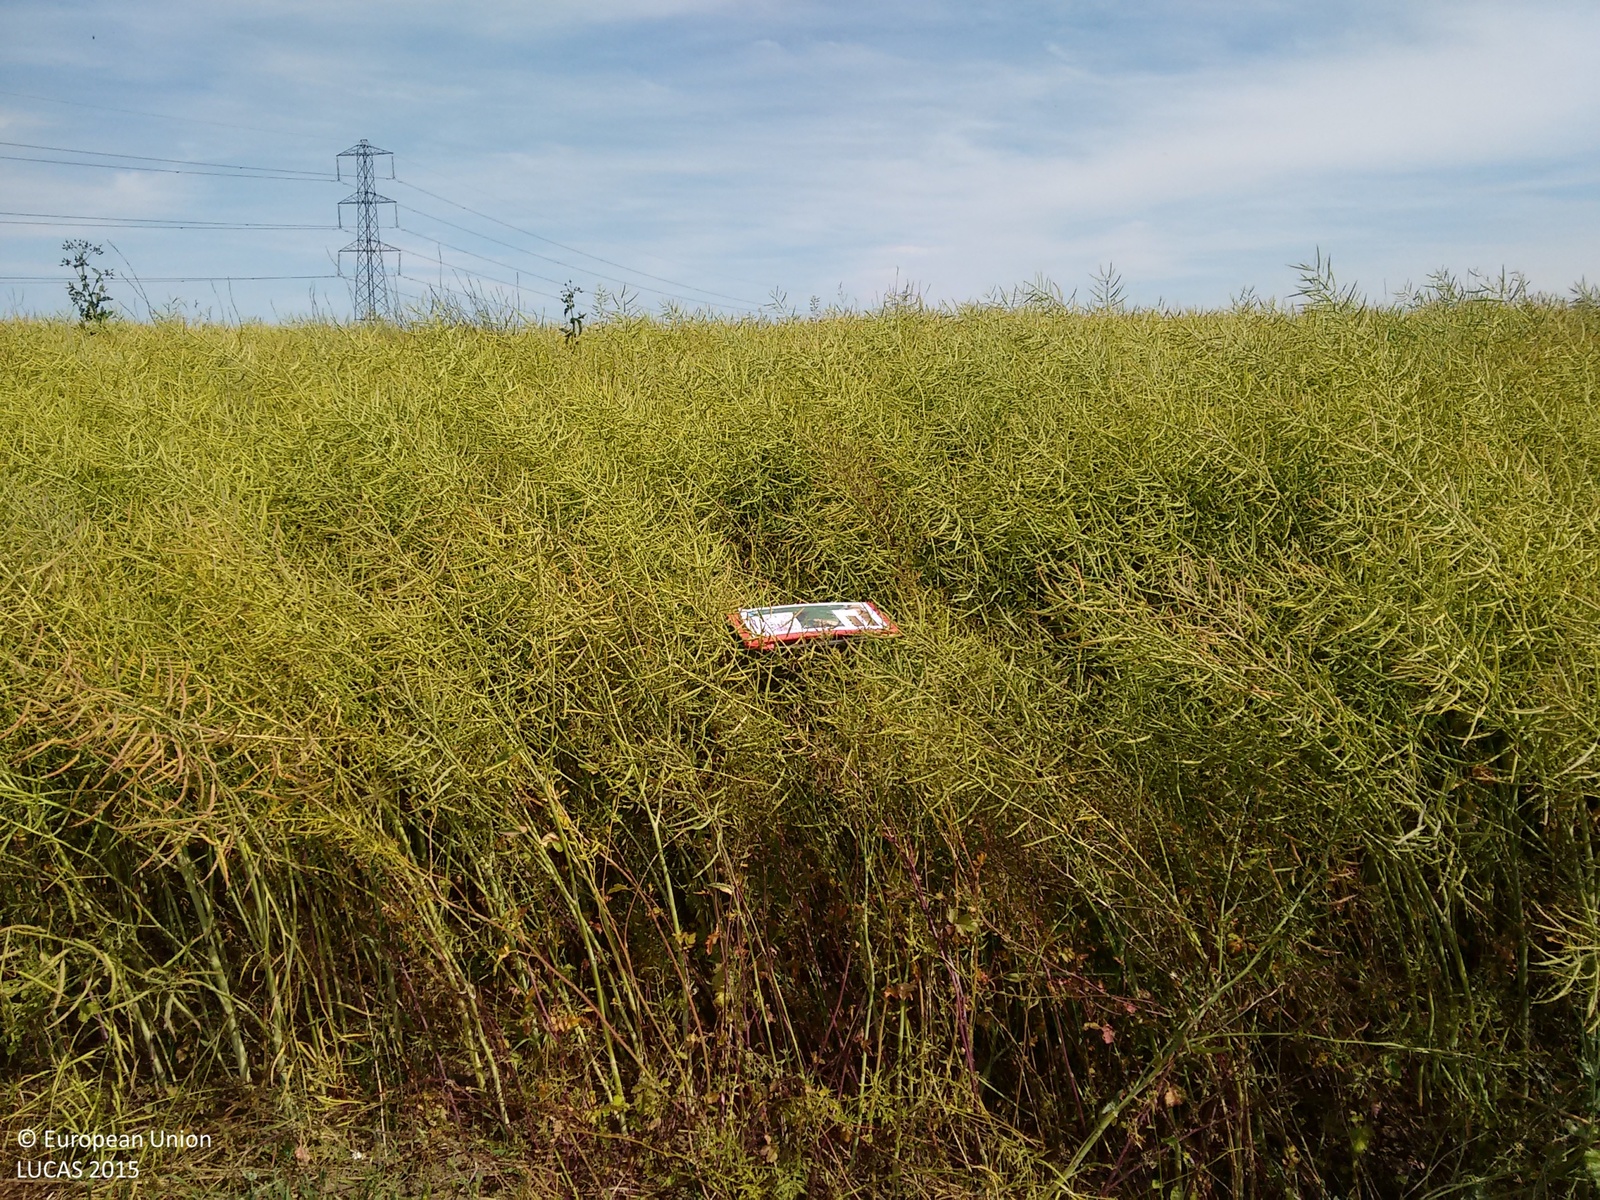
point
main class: Cropland
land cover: Rape and turnip rape
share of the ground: > 75 %
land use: Agriculture (excluding fallow land and kitchen gardens)
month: July
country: GB
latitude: 52.9319
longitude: -1.0386
